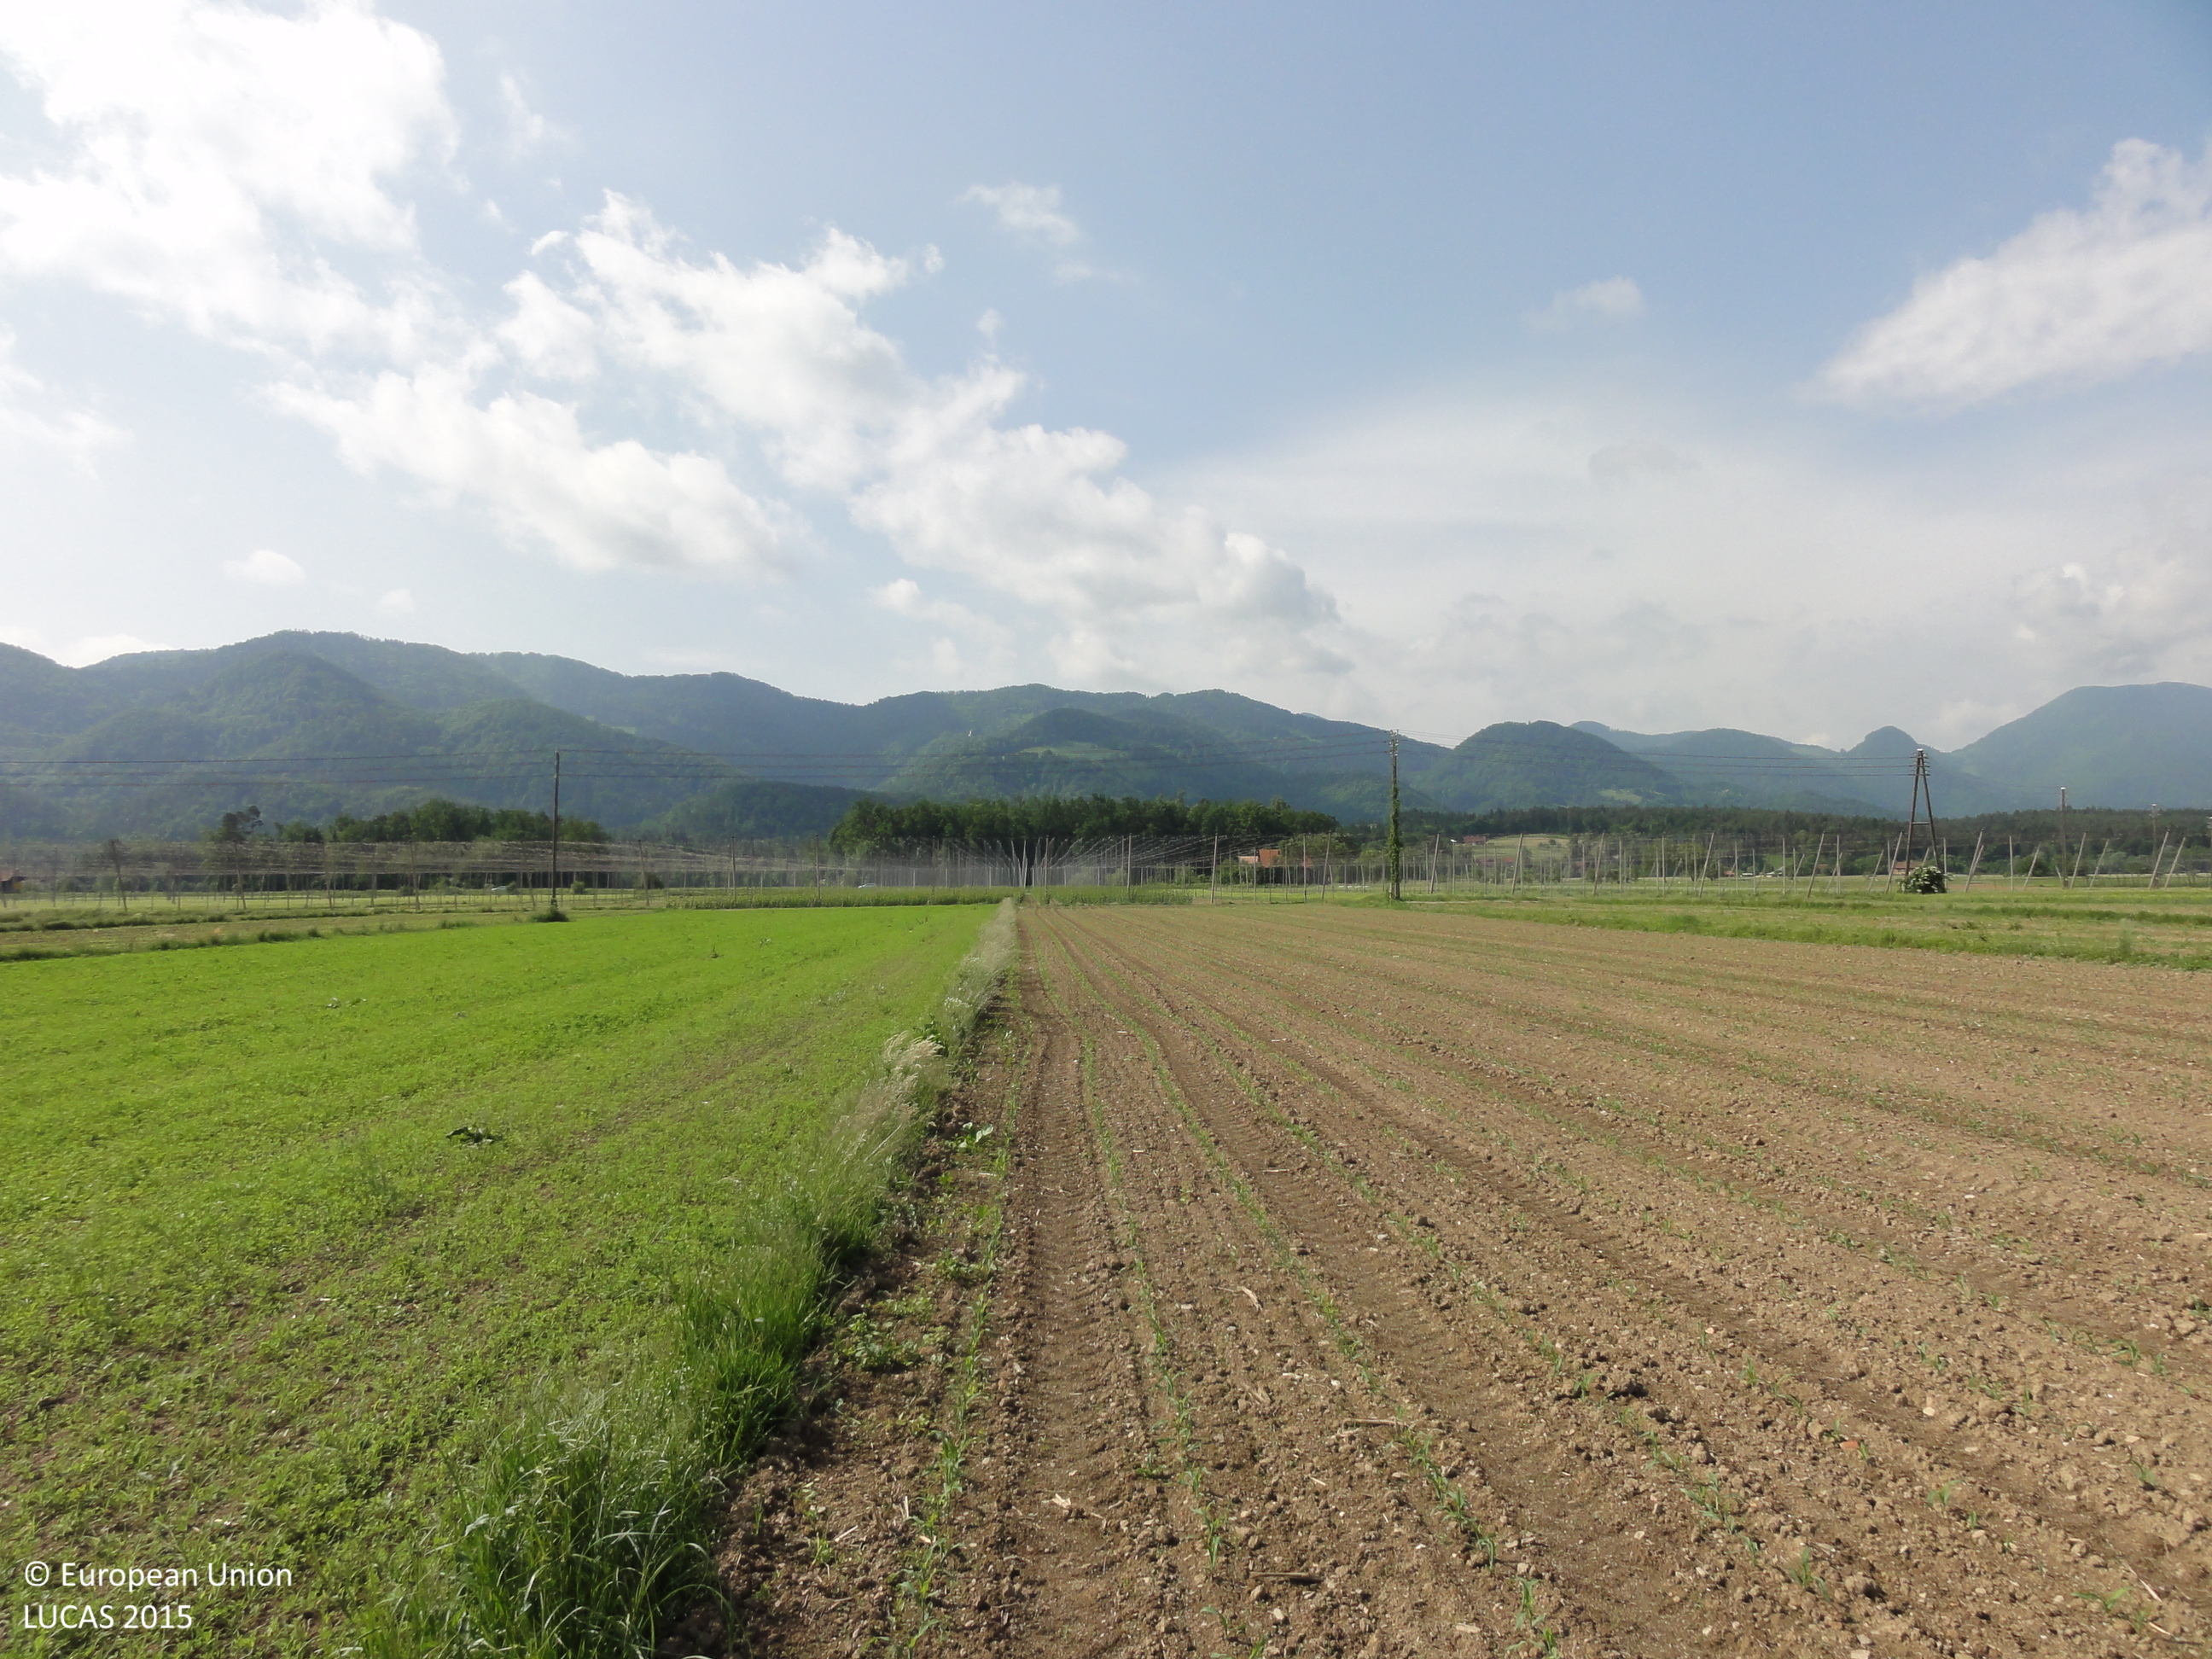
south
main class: Cropland
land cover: Maize
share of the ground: > 75 %
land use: Agriculture (excluding fallow land and kitchen gardens)
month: May
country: SI
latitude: 46.2503
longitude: 15.0432
